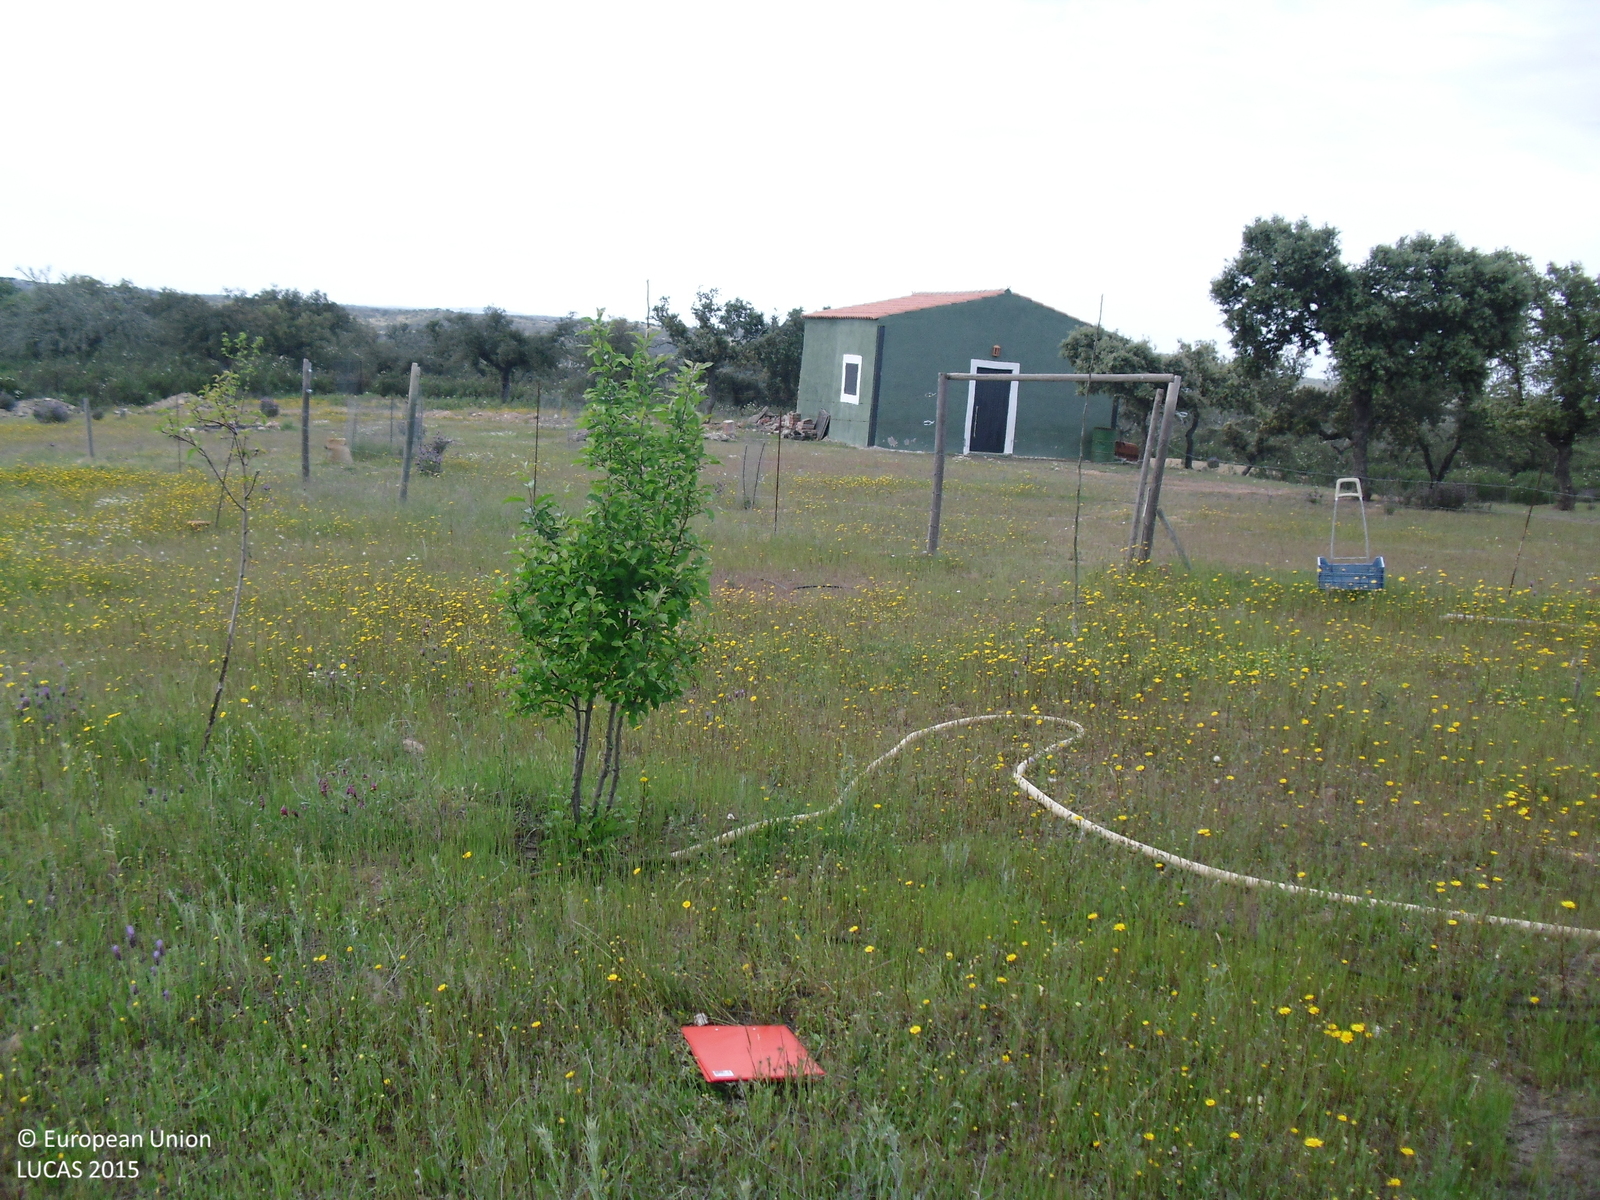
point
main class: Cropland
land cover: Pear fruit
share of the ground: < 10 %
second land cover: Spontaneously vegetated surfaces
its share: > 75 %
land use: Kitchen garden
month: April
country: ES
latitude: 39.3919
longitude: -6.6172
